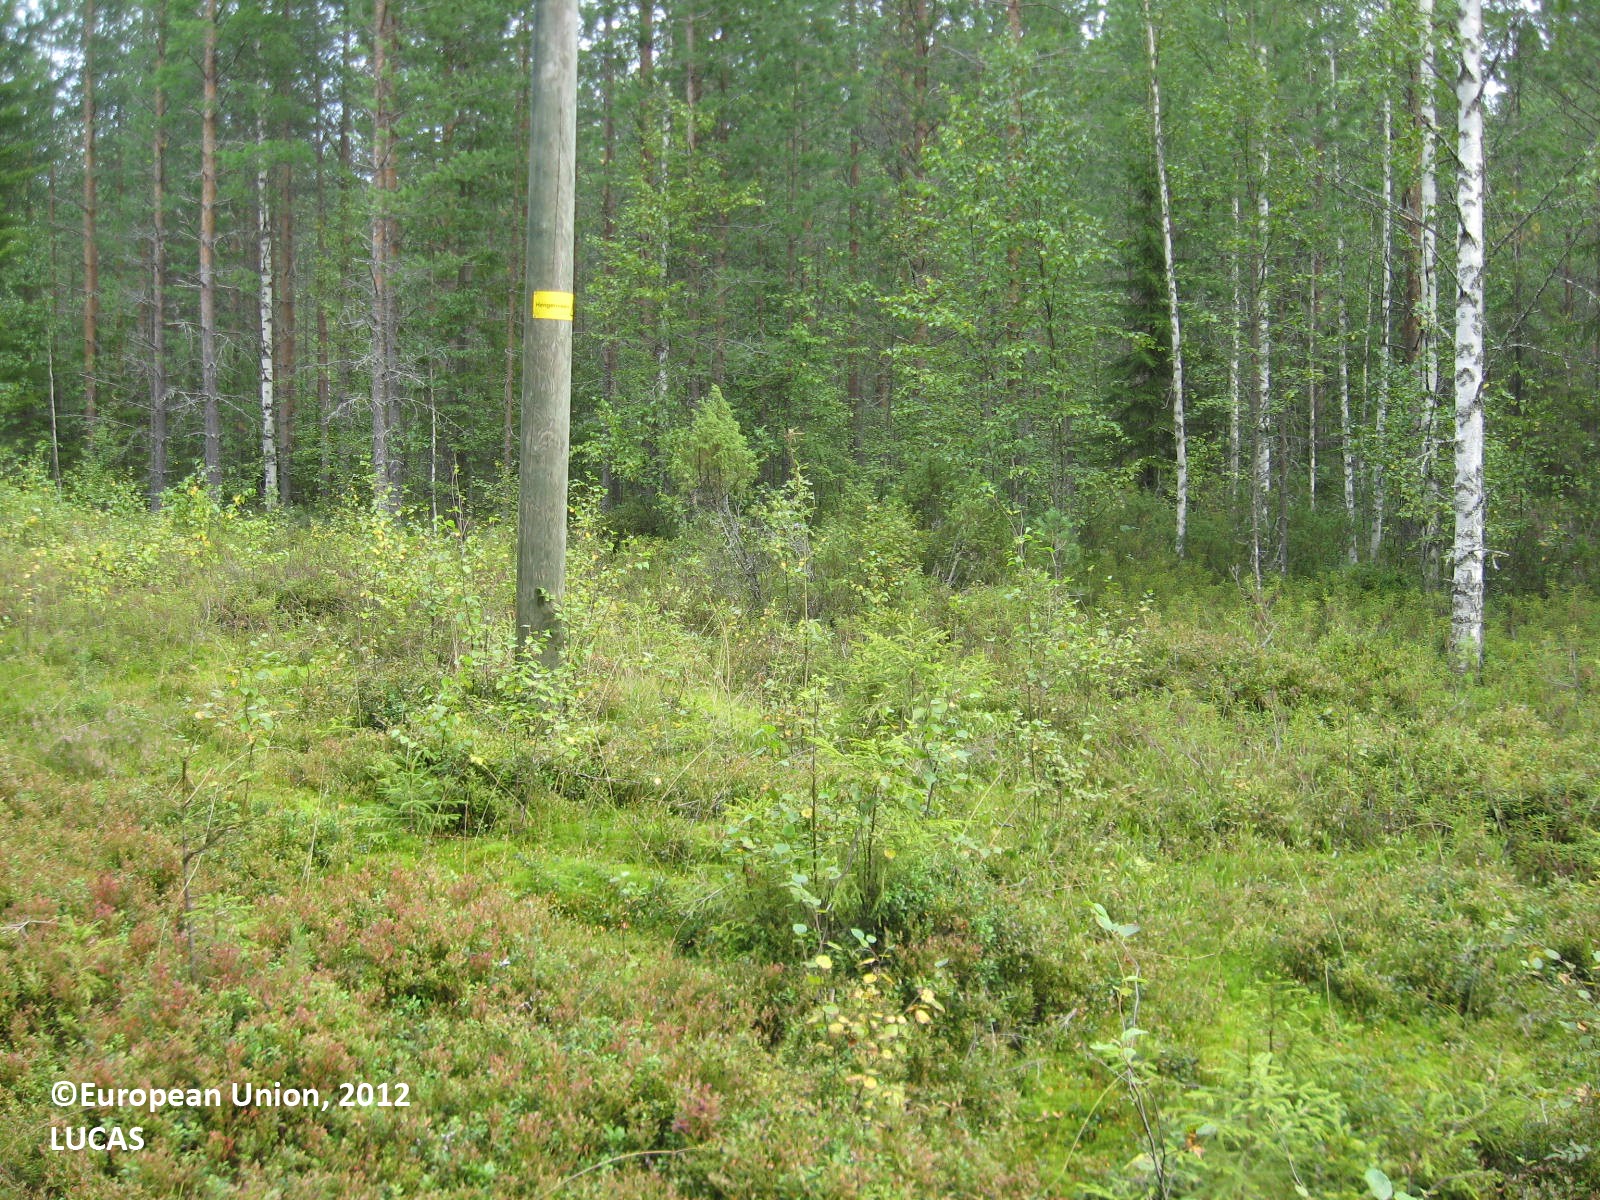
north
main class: Shrubland
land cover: Shrubland with sparse tree cover
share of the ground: > 75 %
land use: Energy production
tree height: < 5 m
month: August
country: FI
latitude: 63.4416
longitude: 29.4092
